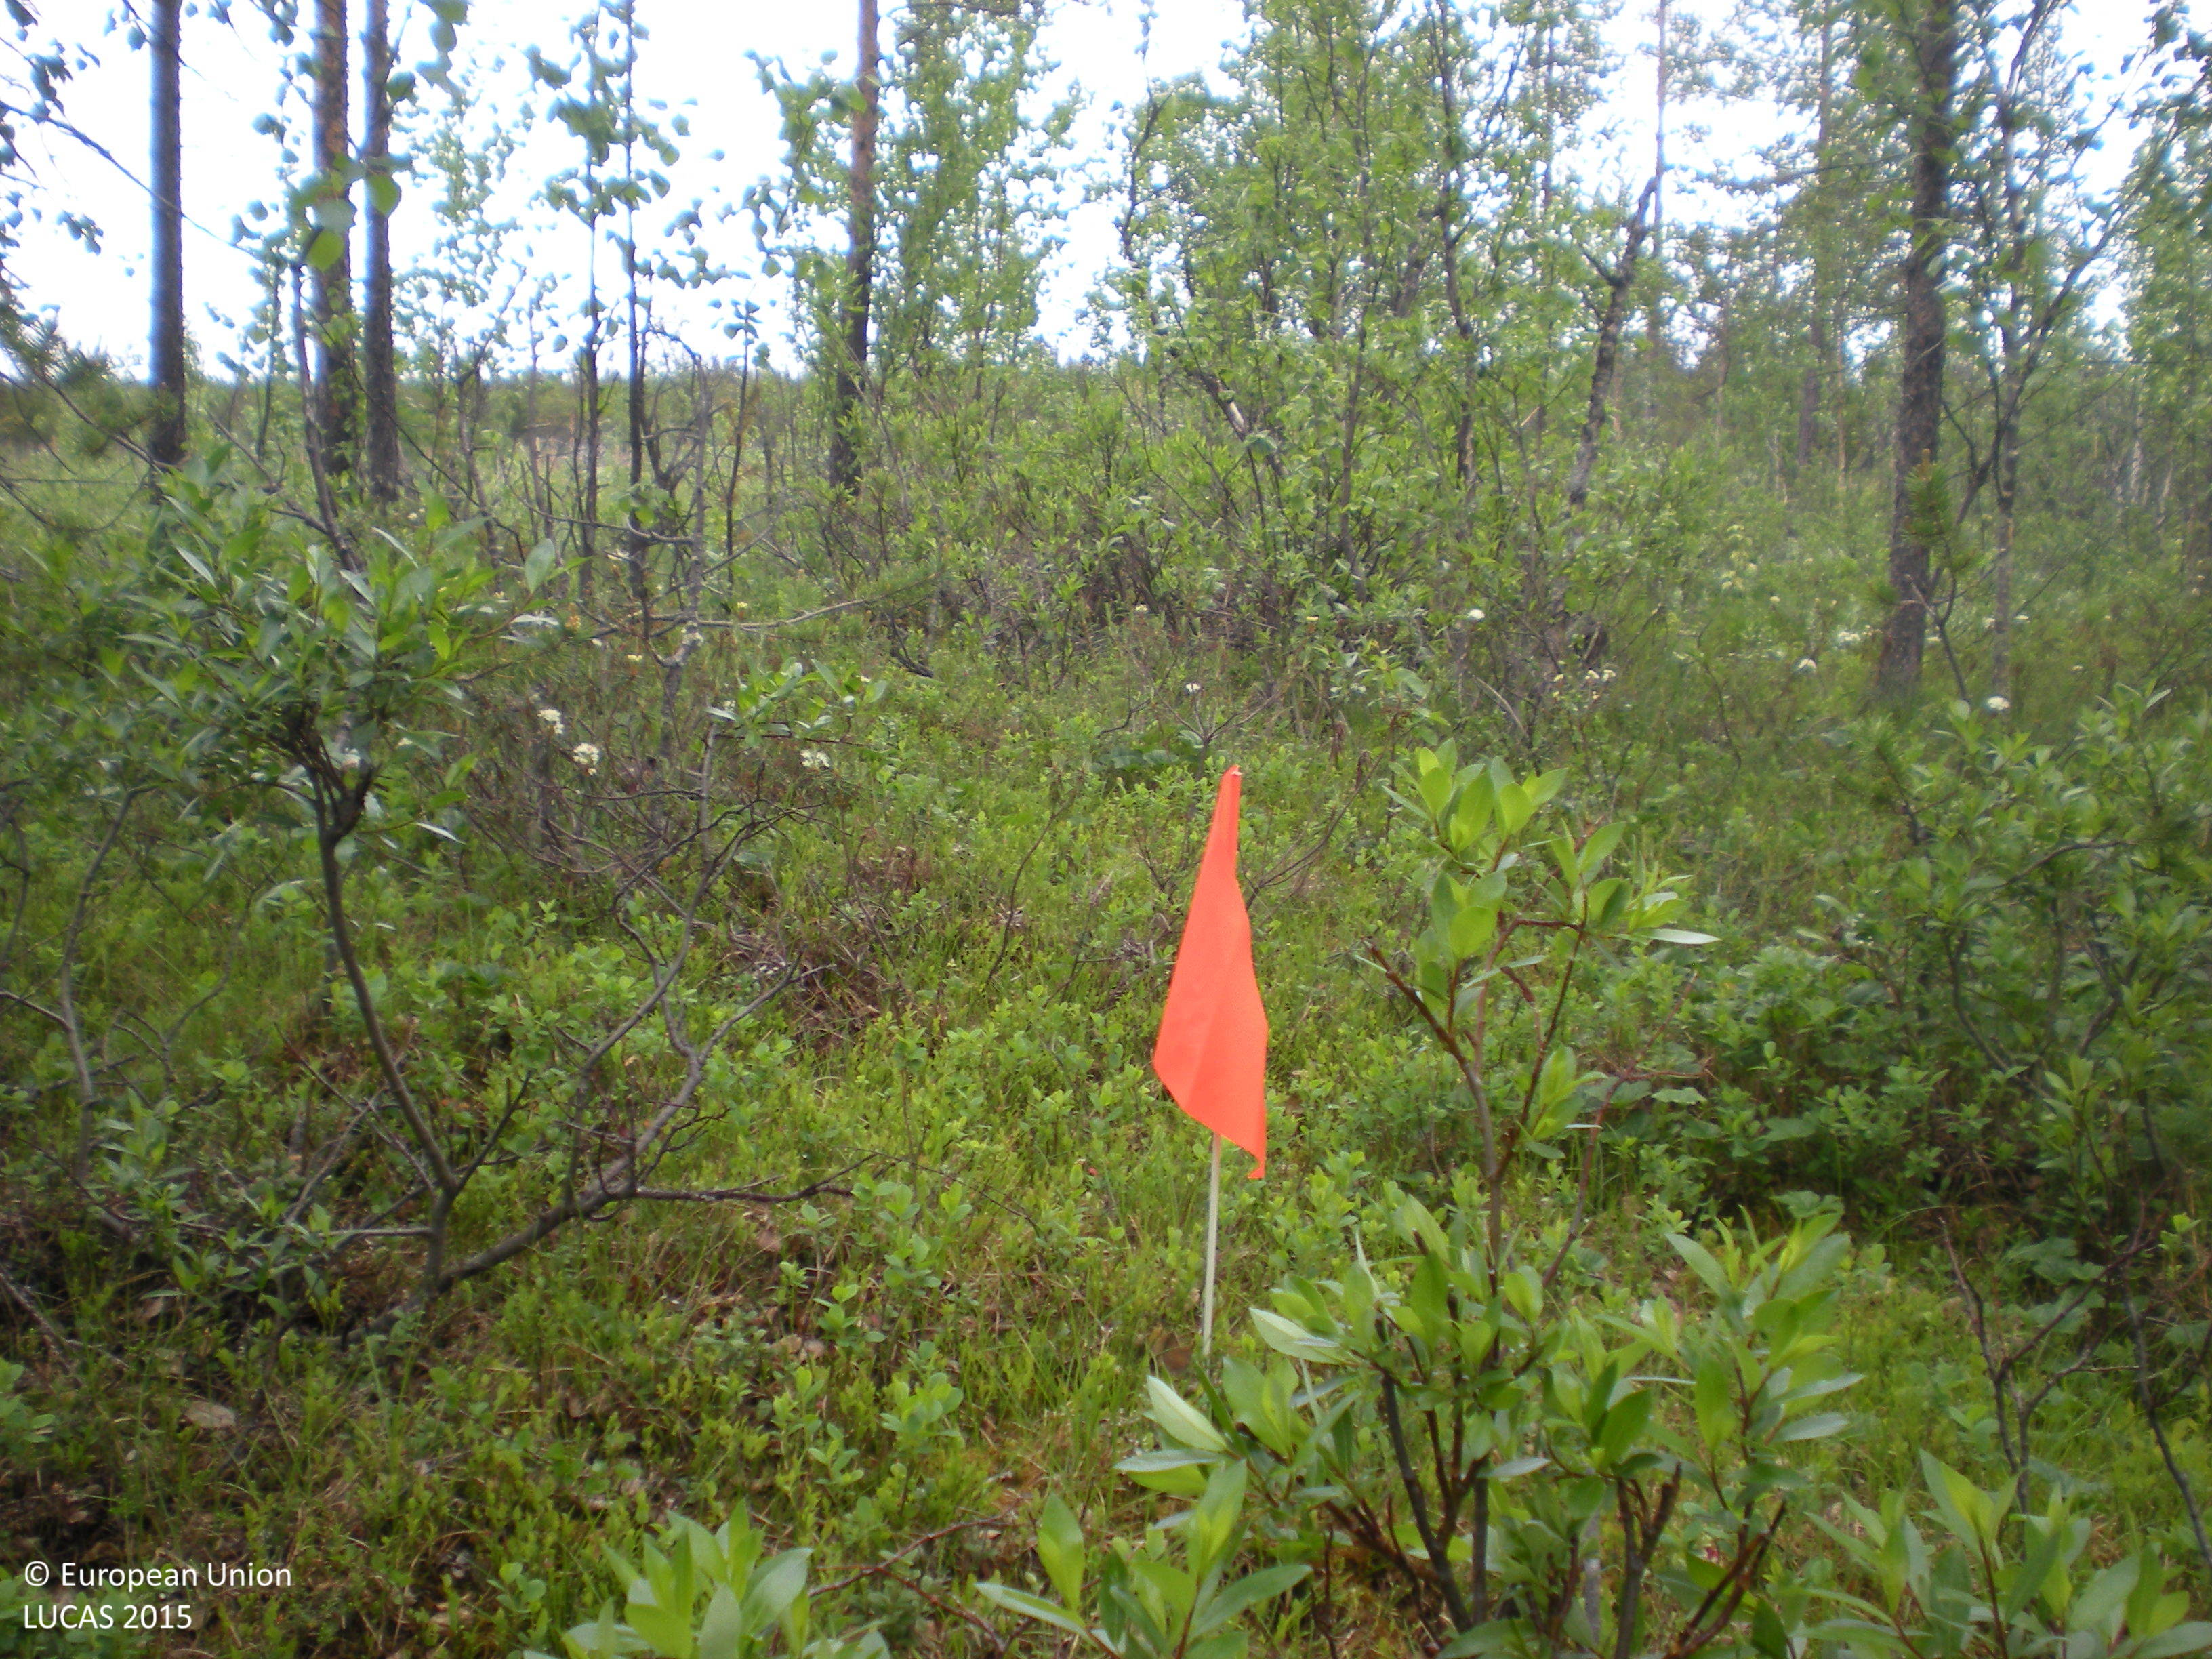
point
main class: Woodland
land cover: Pine dominated mixed woodland
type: mire and swamp forests
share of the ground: 25 - 50 %
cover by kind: broadleaved forest trees 30 %, coniferous forest trees 25 %, shrubs 20 %, herbaceous plants 15 %, lichens and mosses 5 %
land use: Forestry
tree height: < 5 m
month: July
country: SE
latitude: 66.1337
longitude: 17.3751
